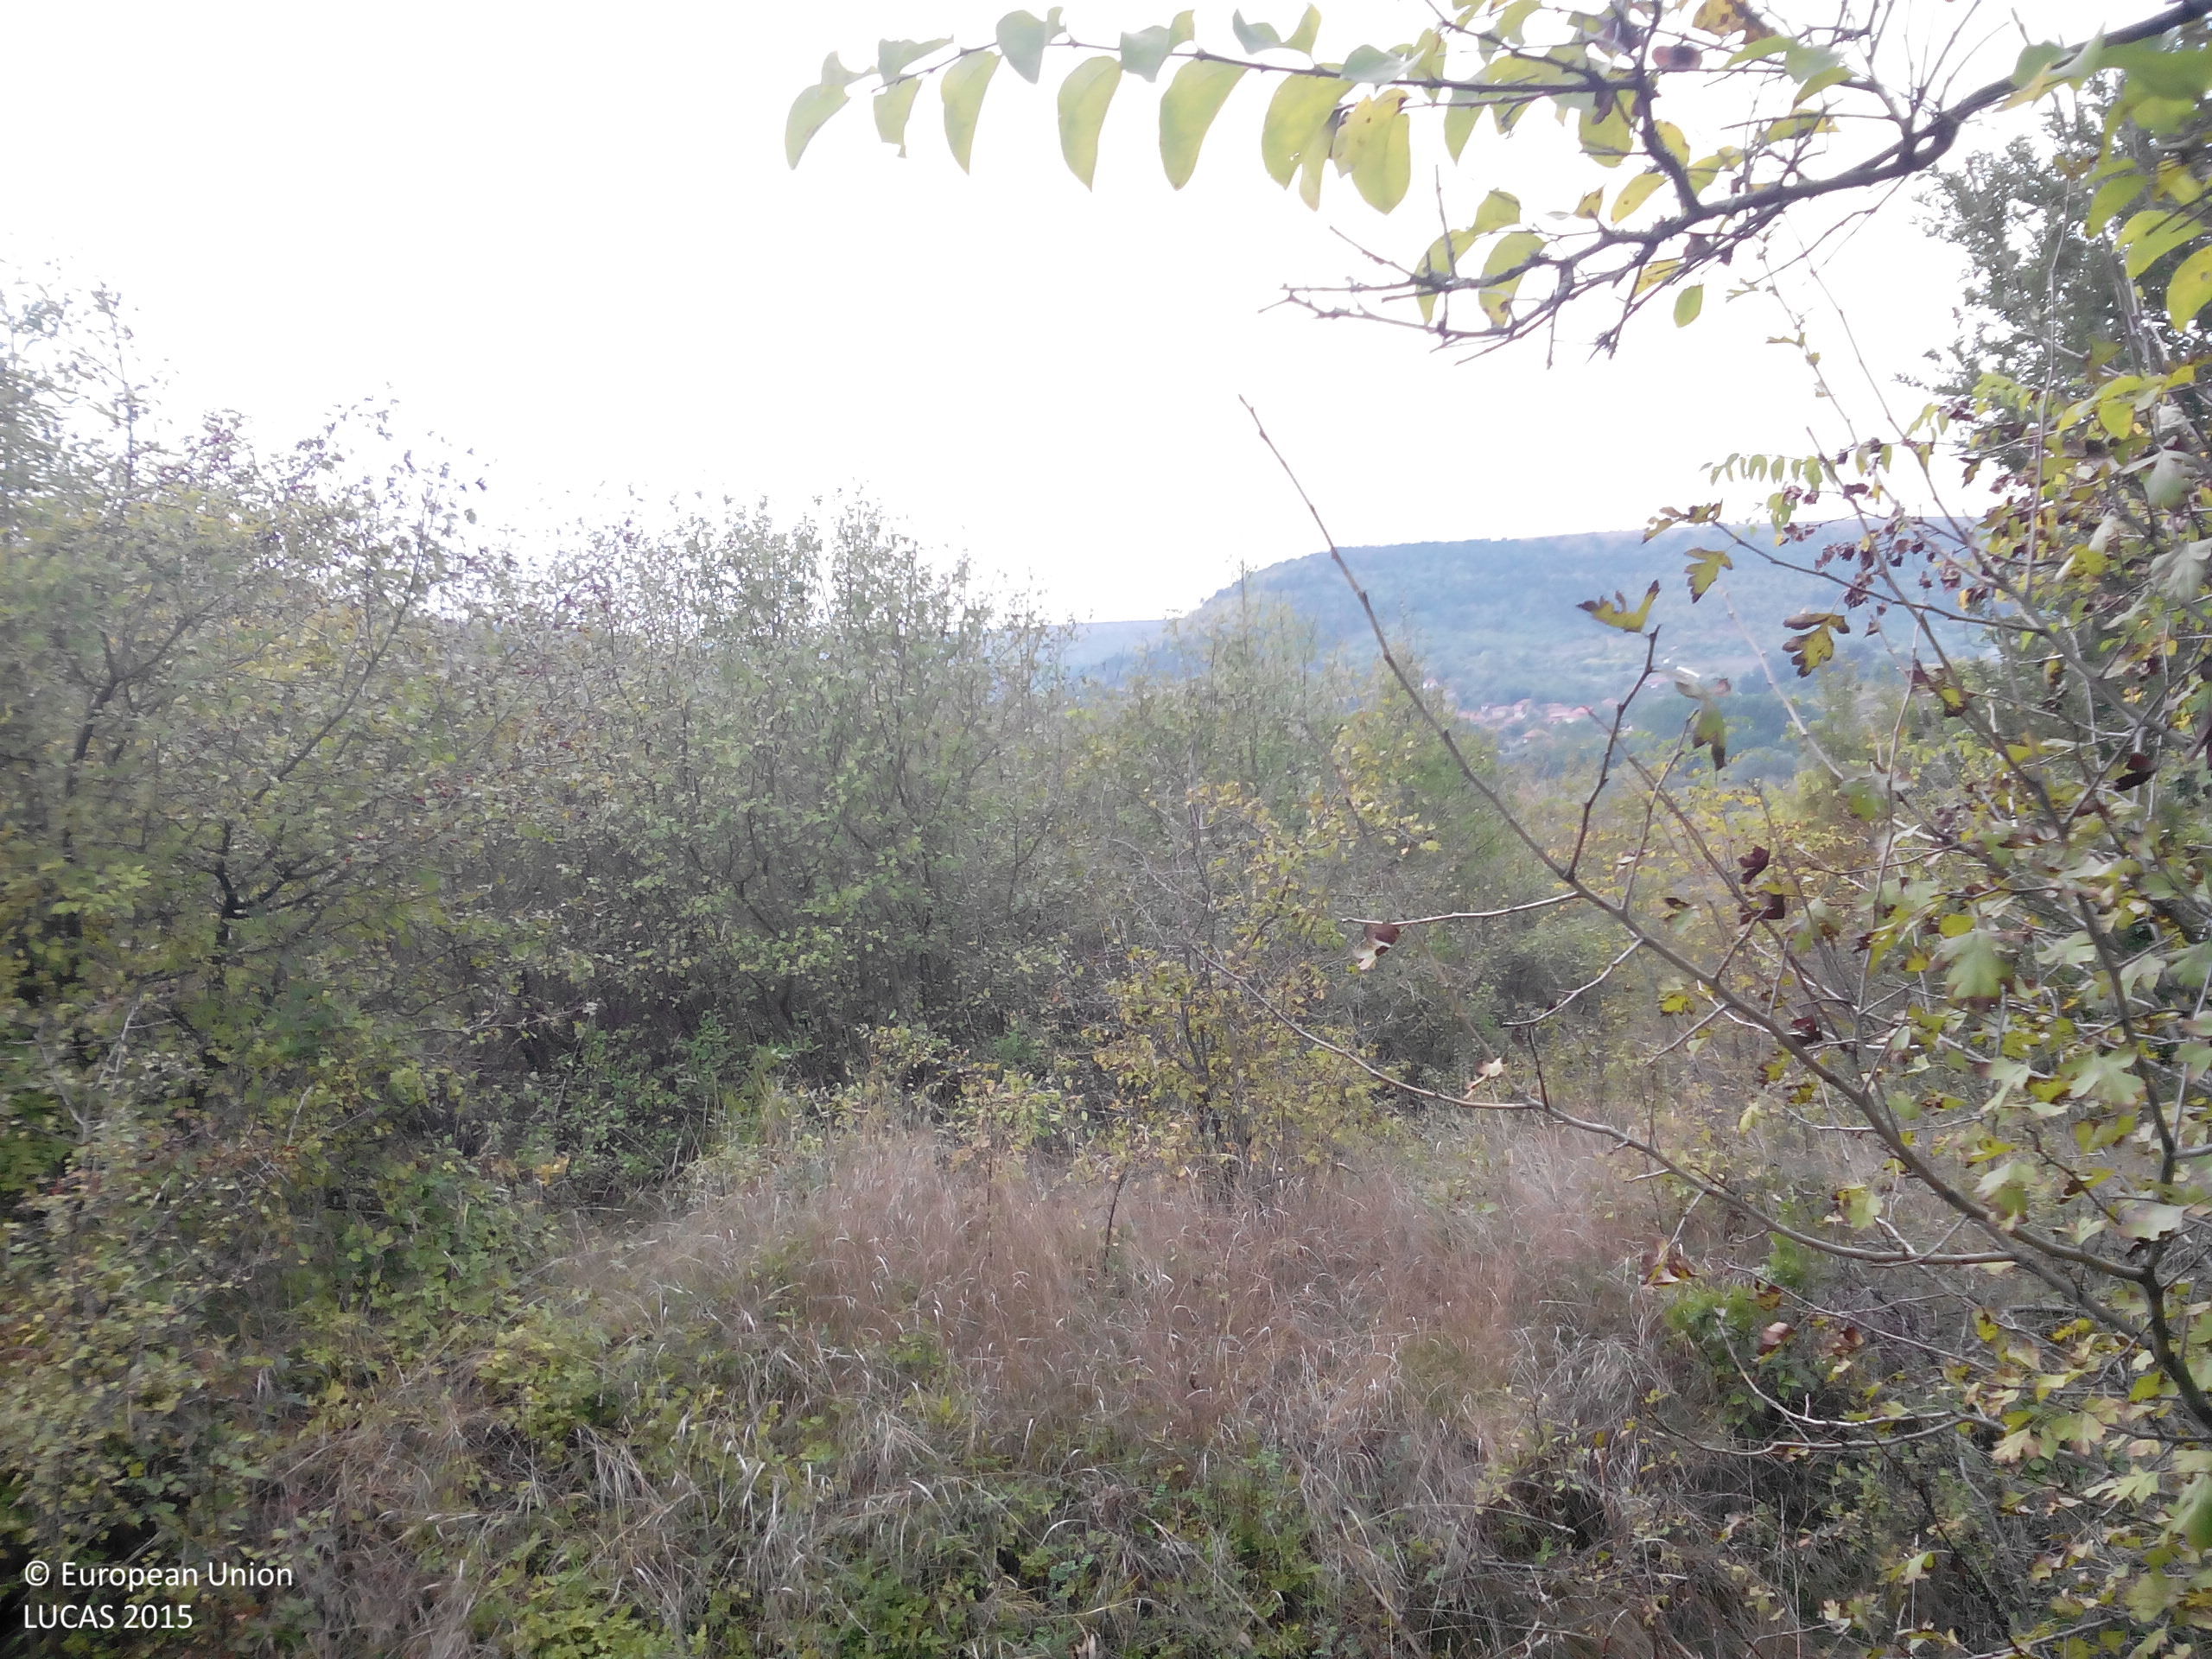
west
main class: Woodland
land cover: Broadleaved woodland
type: mesophytic deciduous forest
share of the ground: 50 - 75 %
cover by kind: broadleaved forest trees 70 %, shrubs 15 %, herbaceous plants 15 %
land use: Forestry
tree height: > 5 m
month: October
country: BG
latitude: 43.2423
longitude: 24.0536
